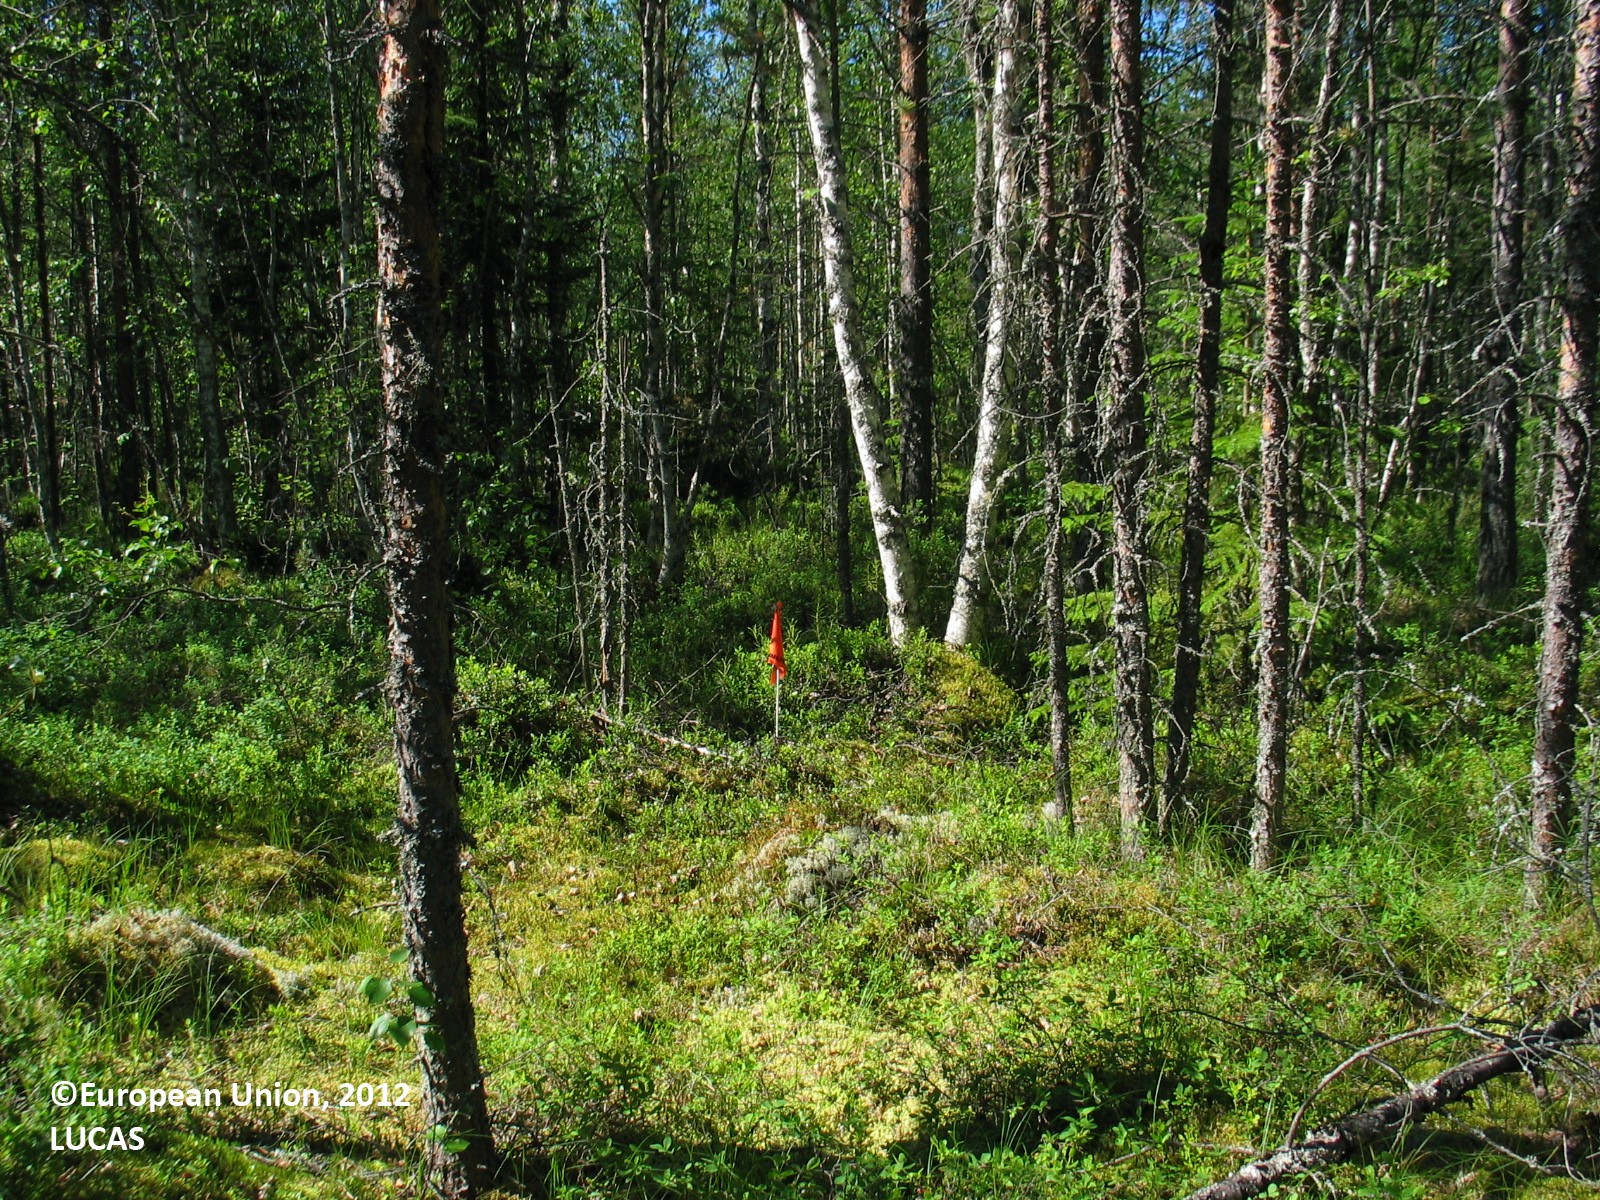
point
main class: Woodland
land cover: Other mixed woodland
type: boreal forest
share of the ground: 50 - 75 %
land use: Forestry
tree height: > 5 m
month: July
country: FI
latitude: 64.4372
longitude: 26.2904
